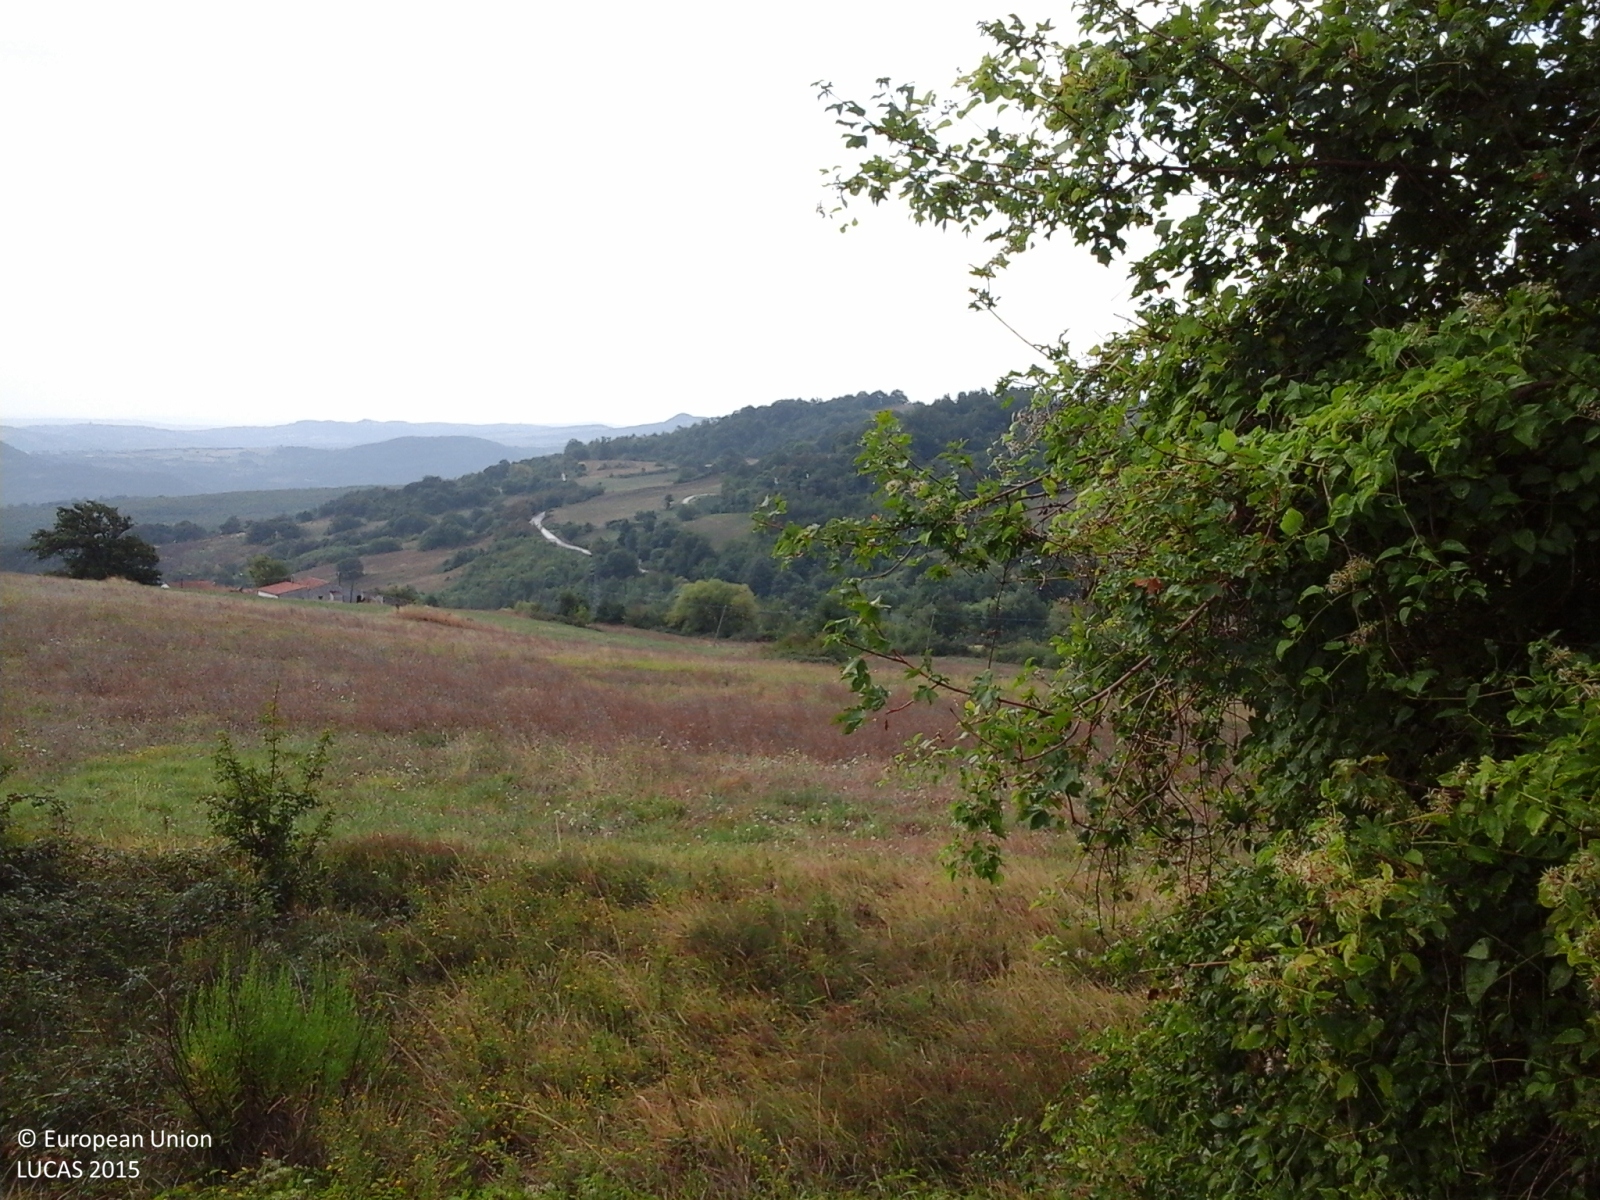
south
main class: Cropland
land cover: Temporary grasslands
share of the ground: > 75 %
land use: Agriculture (excluding fallow land and kitchen gardens)
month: September
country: IT
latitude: 41.7264
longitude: 14.3968
